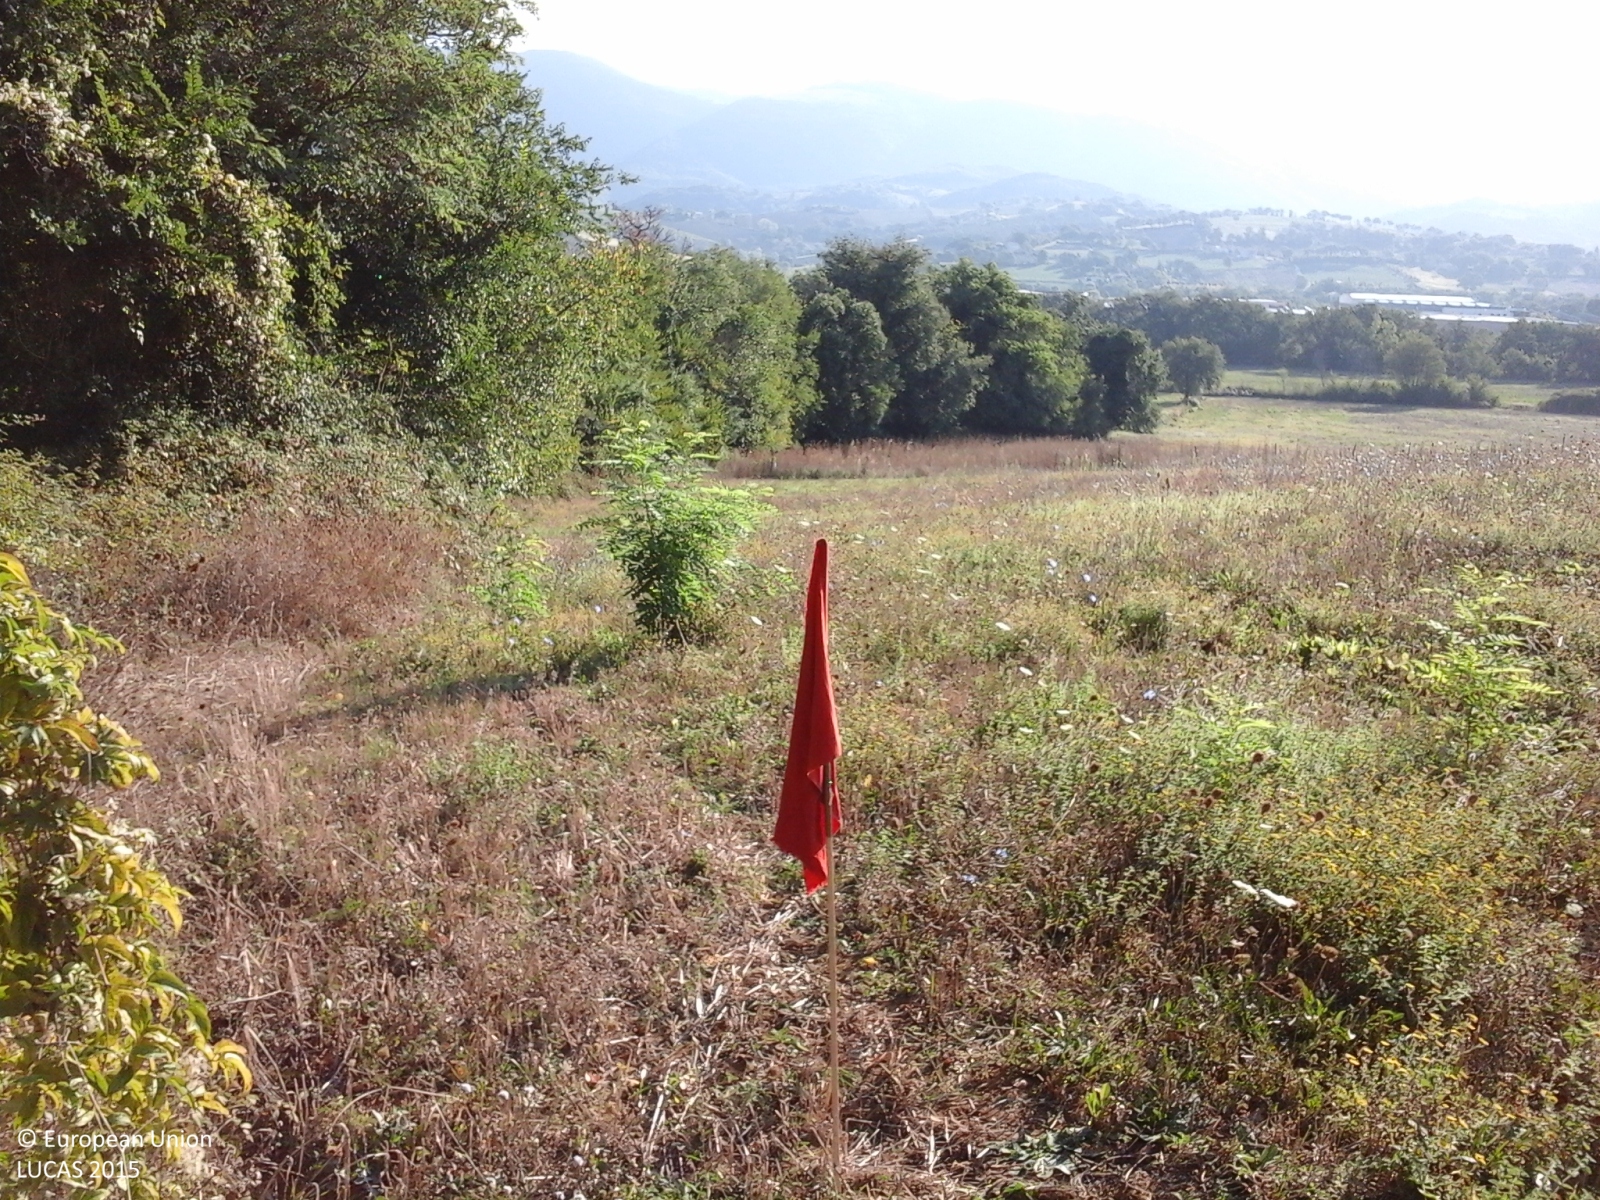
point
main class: Cropland
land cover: Durum wheat
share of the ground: < 10 %
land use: Agriculture (excluding fallow land and kitchen gardens)
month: September
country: IT
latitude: 43.2785
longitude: 12.9864
